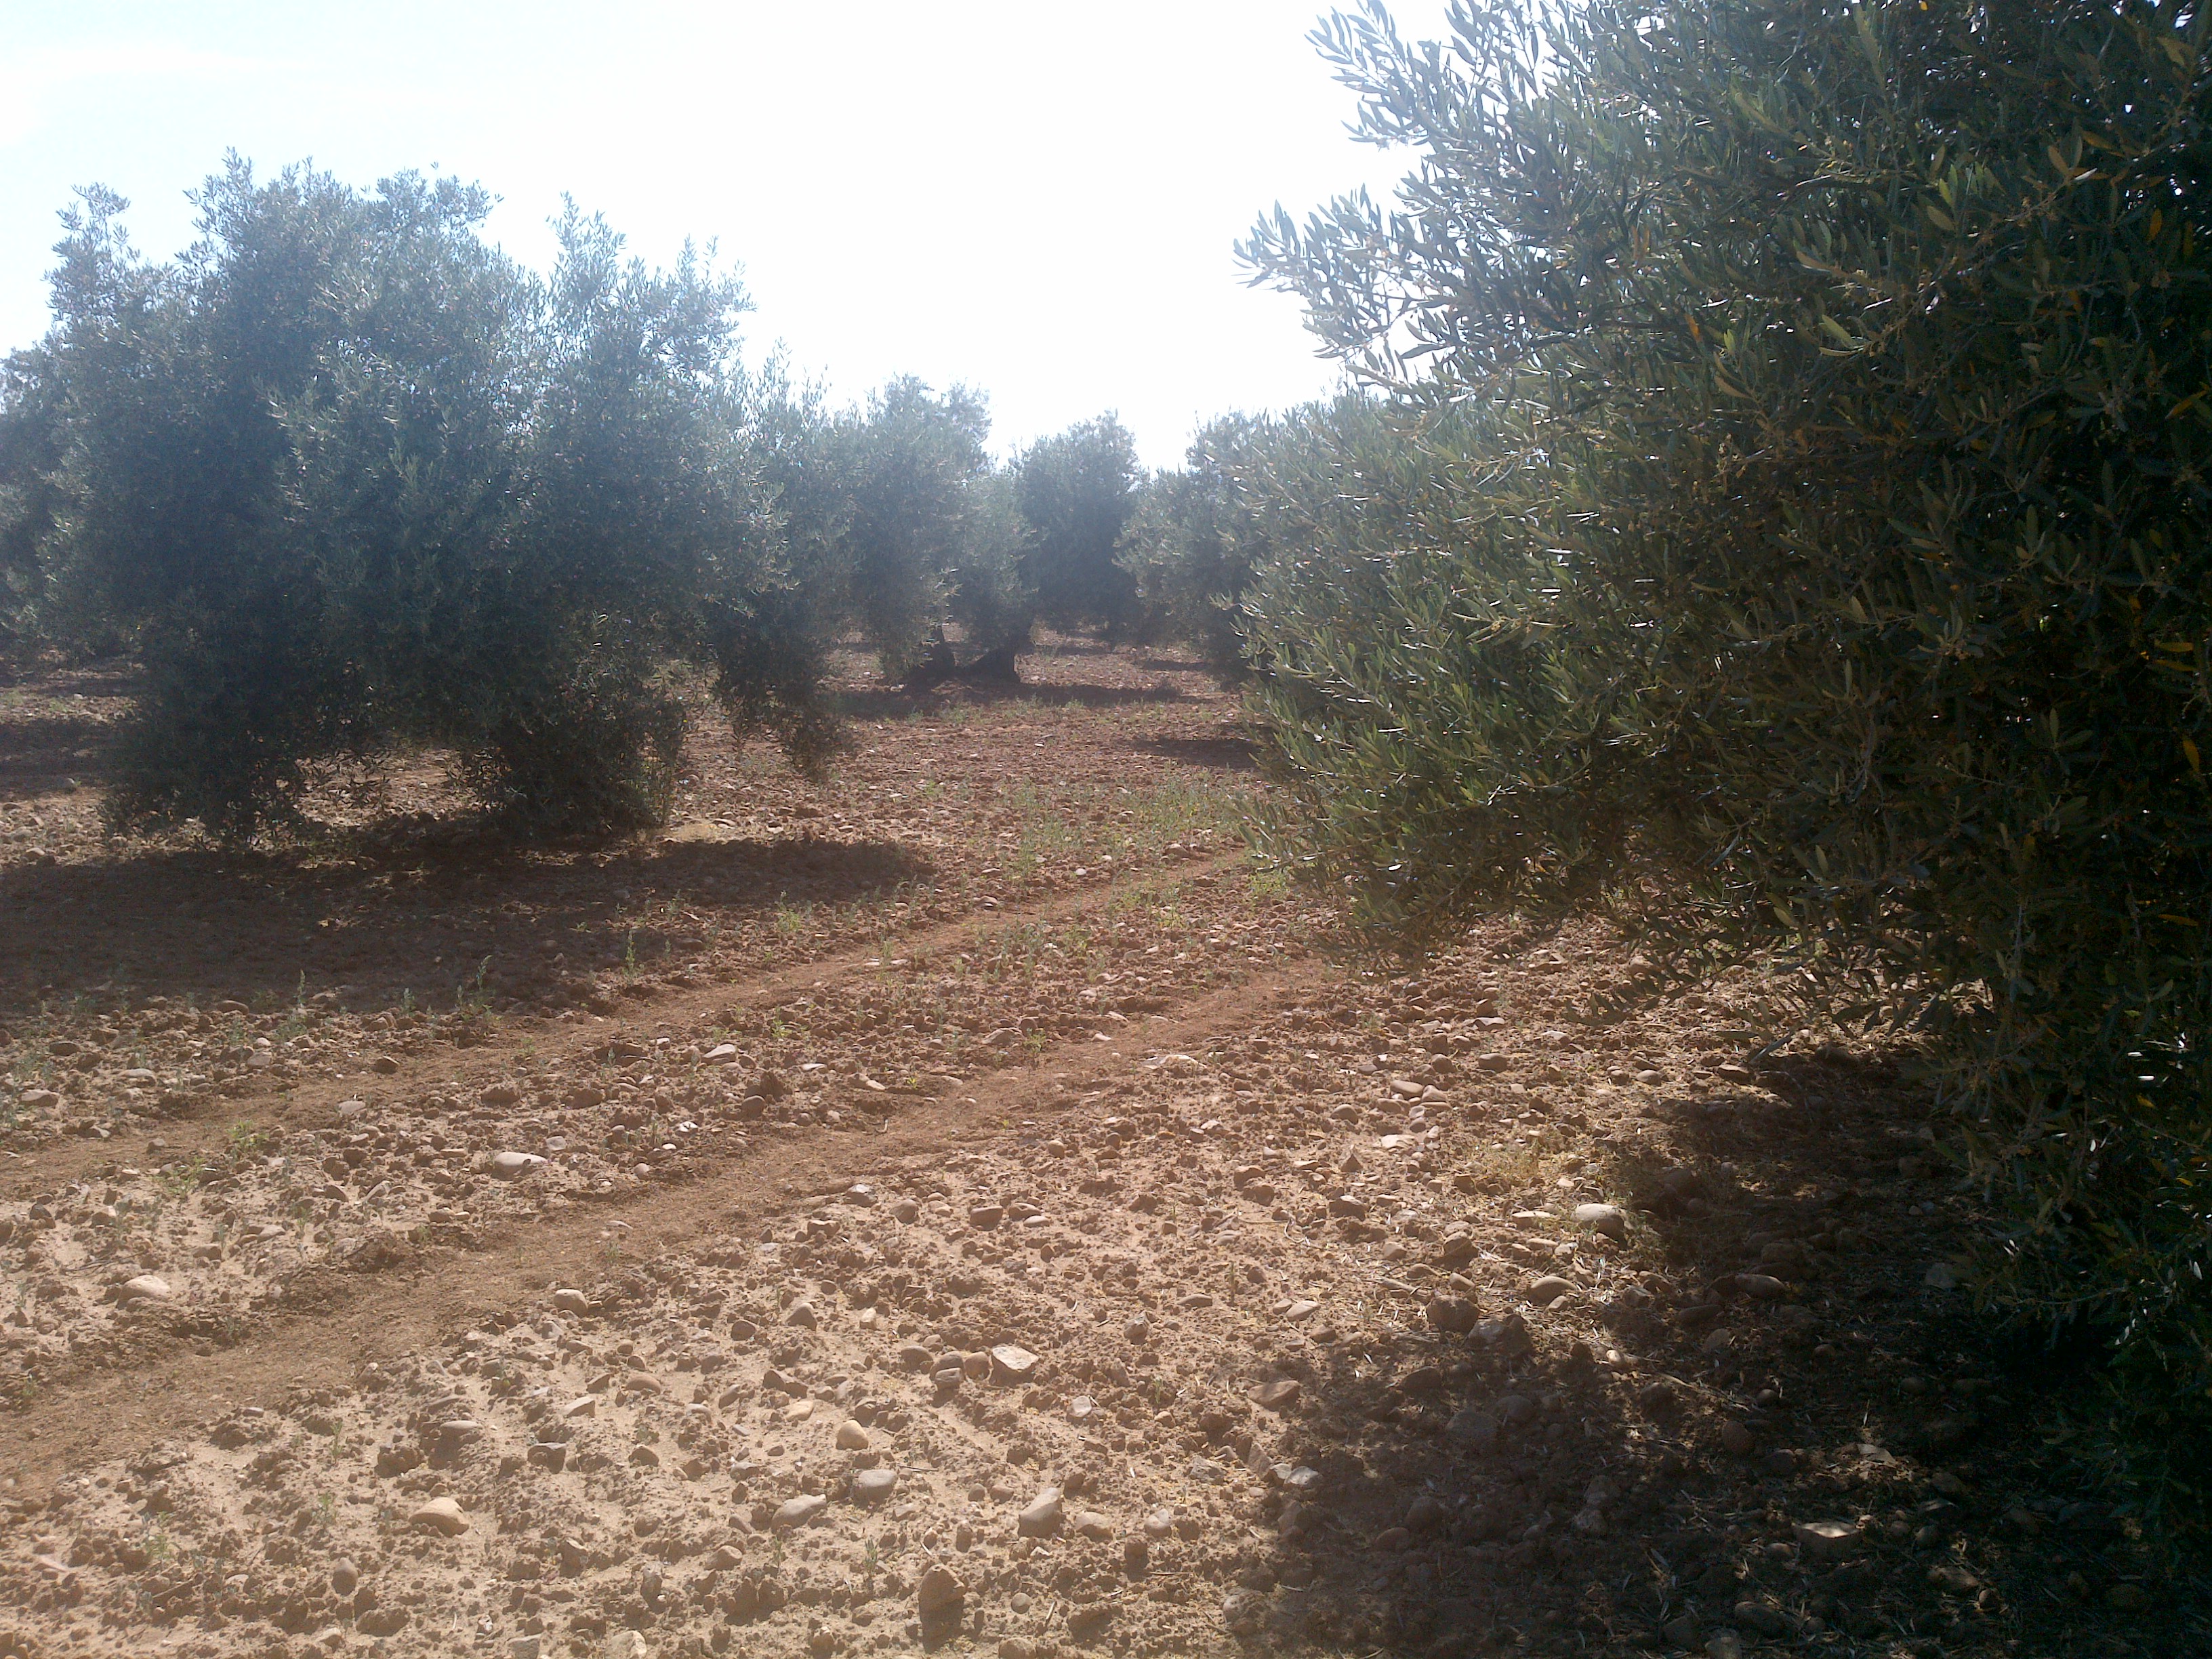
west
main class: Cropland
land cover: Olive groves
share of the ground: 50 - 75 %
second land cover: Other bare soil
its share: > 75 %
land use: Agriculture (excluding fallow land and kitchen gardens)
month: May
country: ES
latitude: 37.9082
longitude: -4.6742
